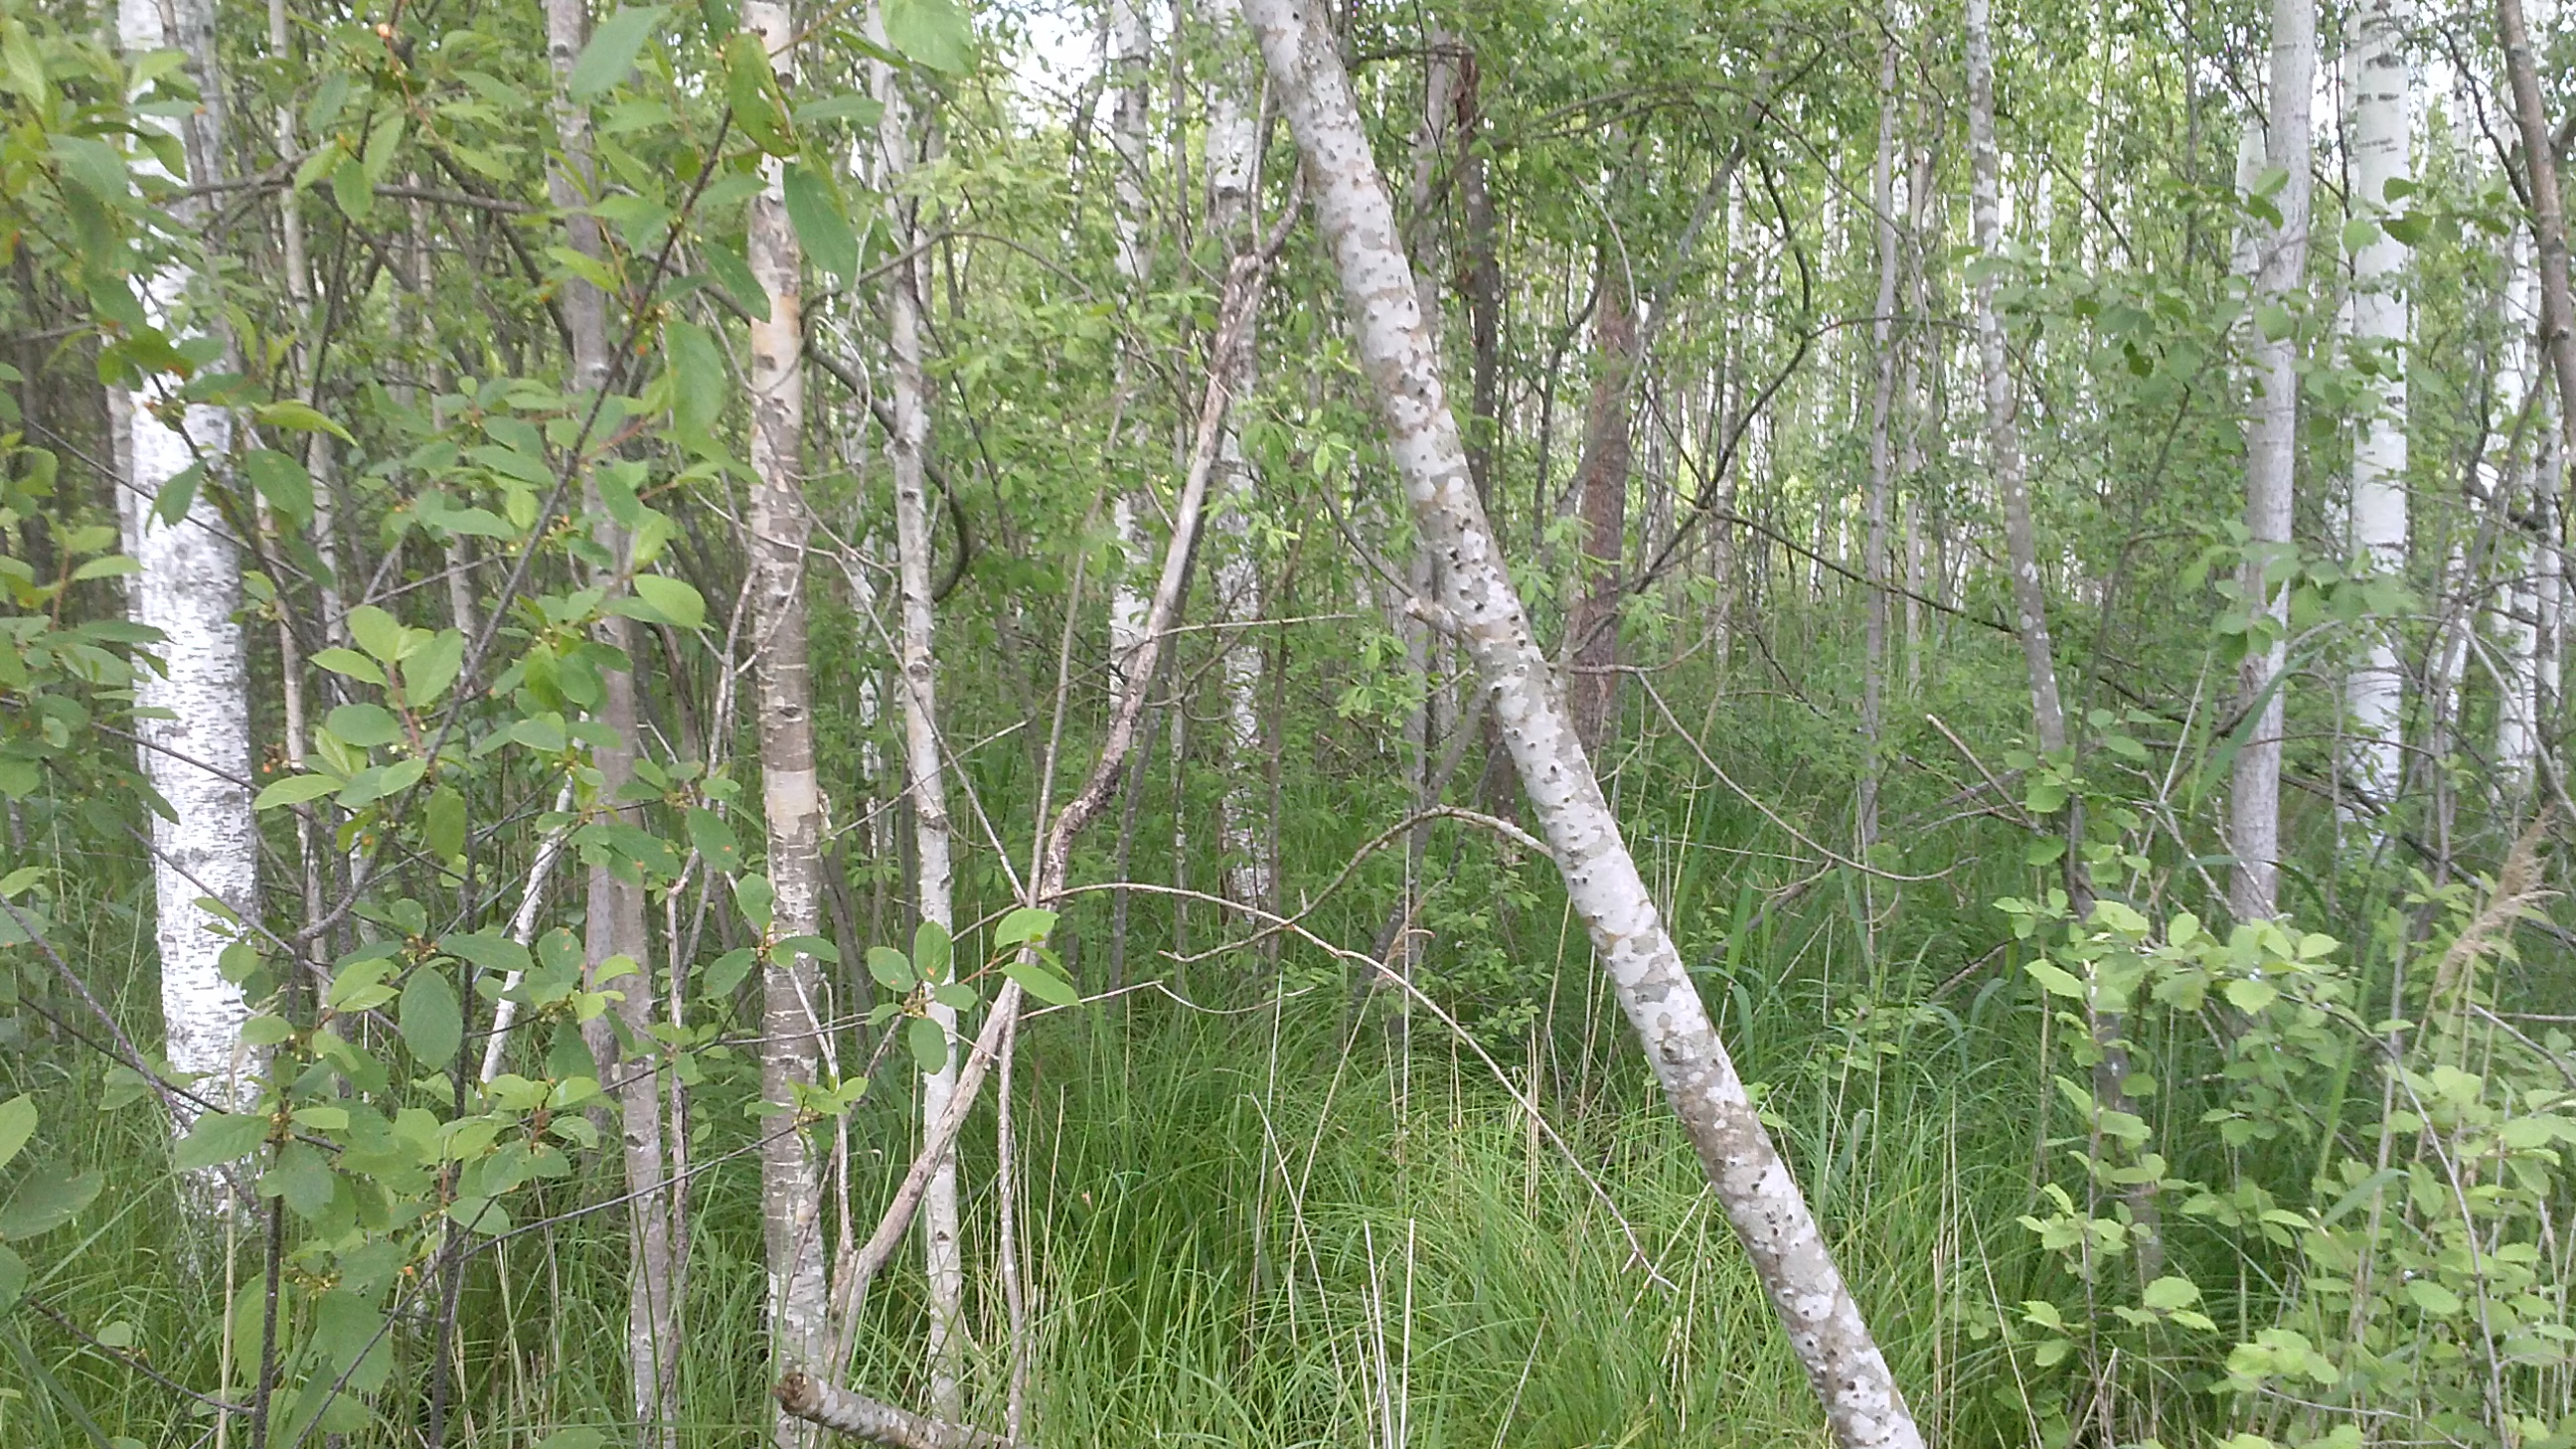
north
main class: Woodland
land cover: Broadleaved woodland
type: non-riverine alder, birch or aspen forest
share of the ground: 50 - 75 %
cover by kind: broadleaved forest trees 70 %, shrubs 20 %, herbaceous plants 10 %
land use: Forestry
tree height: > 5 m
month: June
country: LV
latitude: 56.4745
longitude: 27.3001
